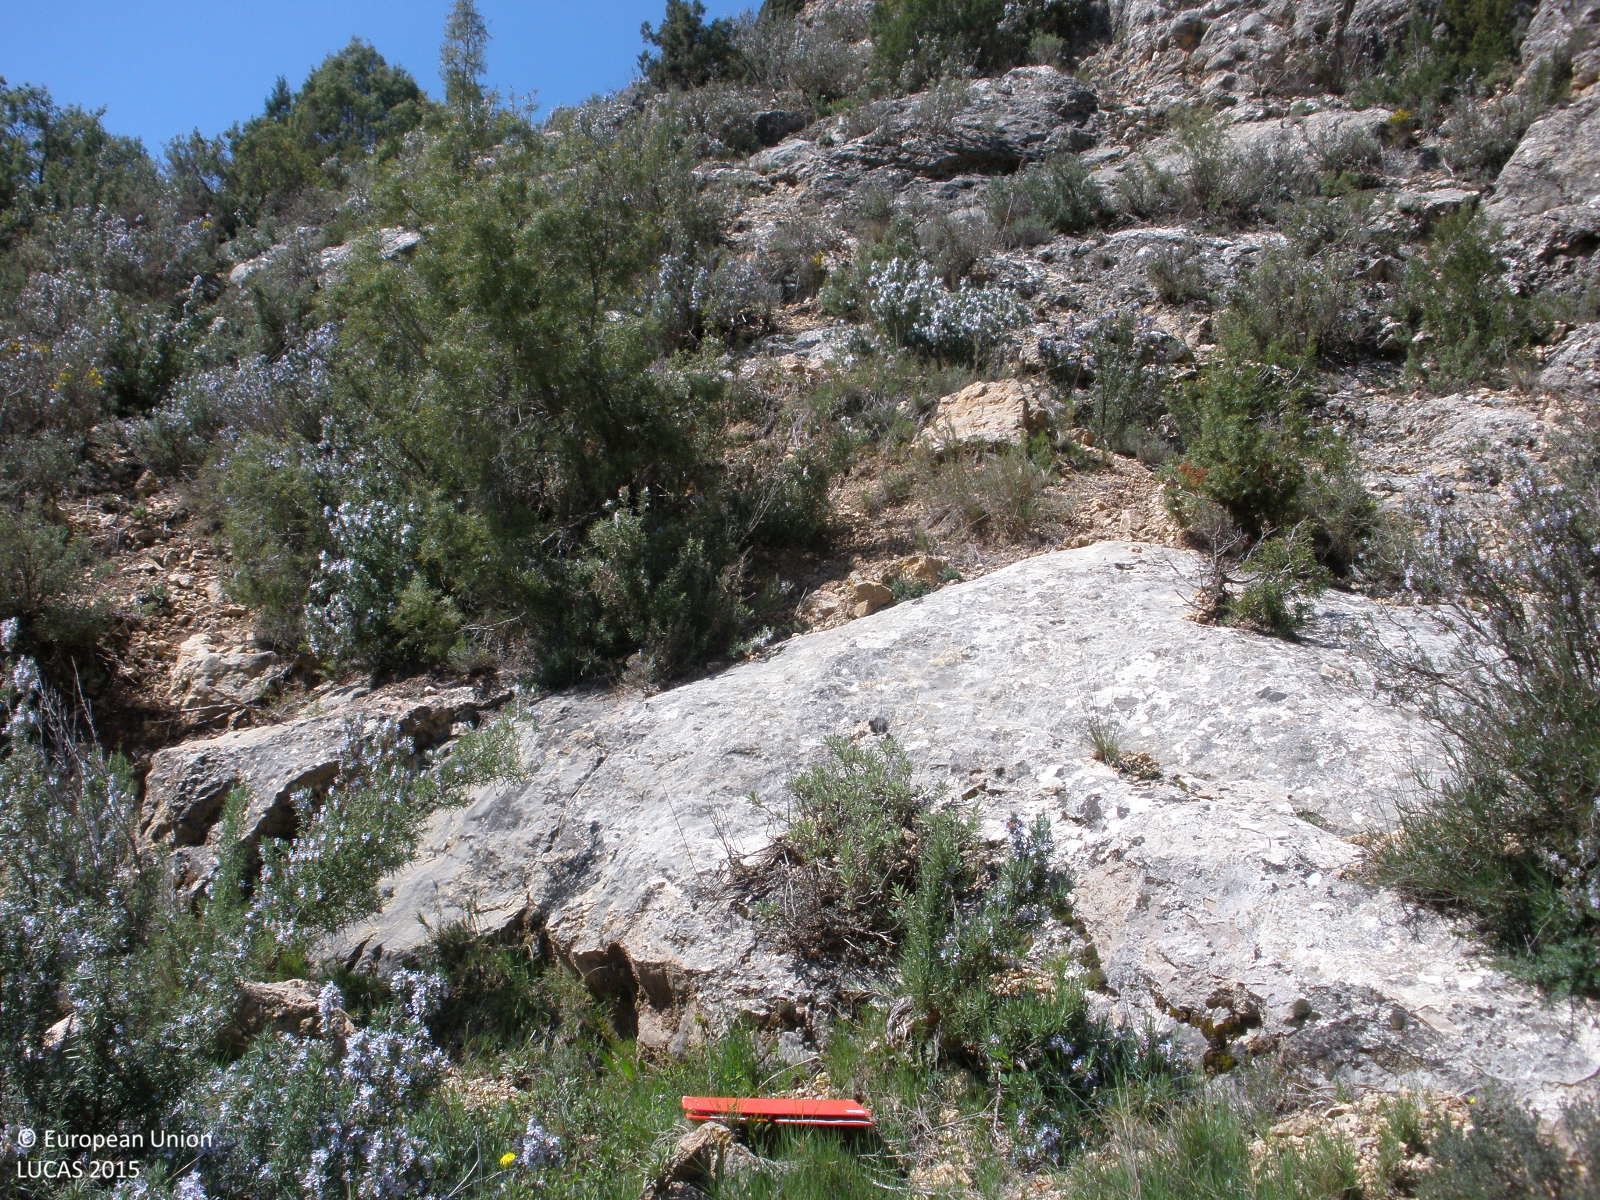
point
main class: Woodland
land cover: Pine dominated coniferous woodland
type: coniferous forest of the mediterranean region
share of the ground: 25 - 50 %
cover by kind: shrubs 45 %, consolidated bare surface 30 %, coniferous forest trees 25 %
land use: Semi-natural and natural areas not in use
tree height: > 5 m
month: April
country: ES
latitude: 40.2223
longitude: -1.2329
